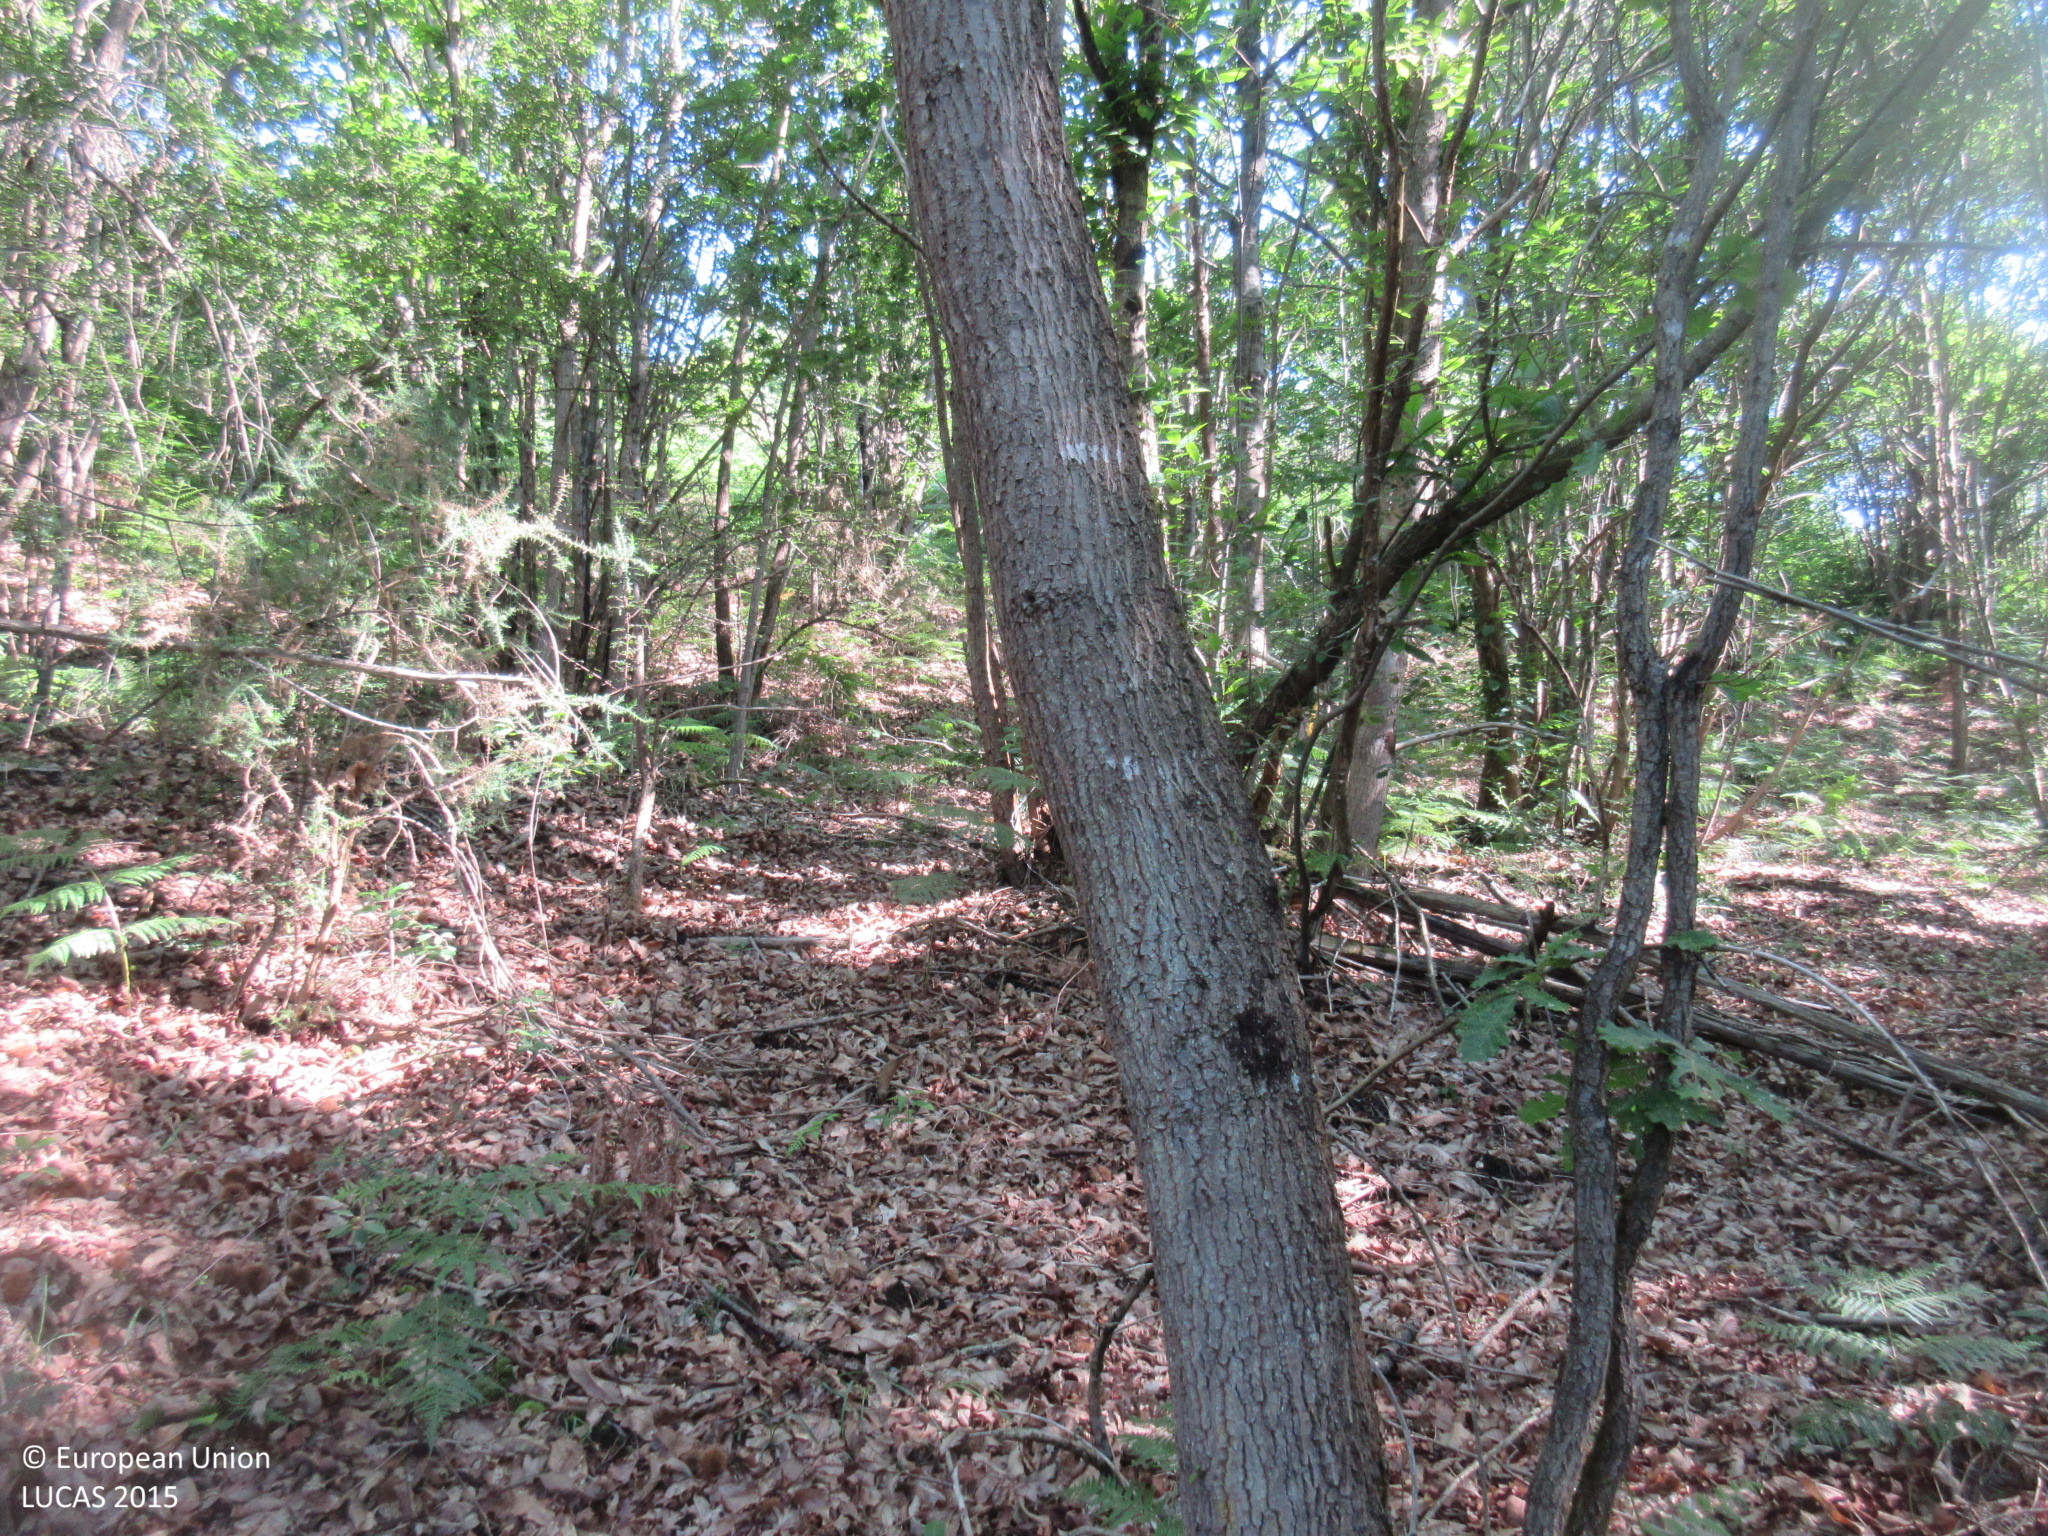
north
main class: Woodland
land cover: Broadleaved woodland
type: thermophilous deciduous forest
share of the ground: > 75 %
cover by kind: broadleaved forest trees 100 %
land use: Forestry
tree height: > 5 m
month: June
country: ES
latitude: 43.3885
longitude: -6.0292
